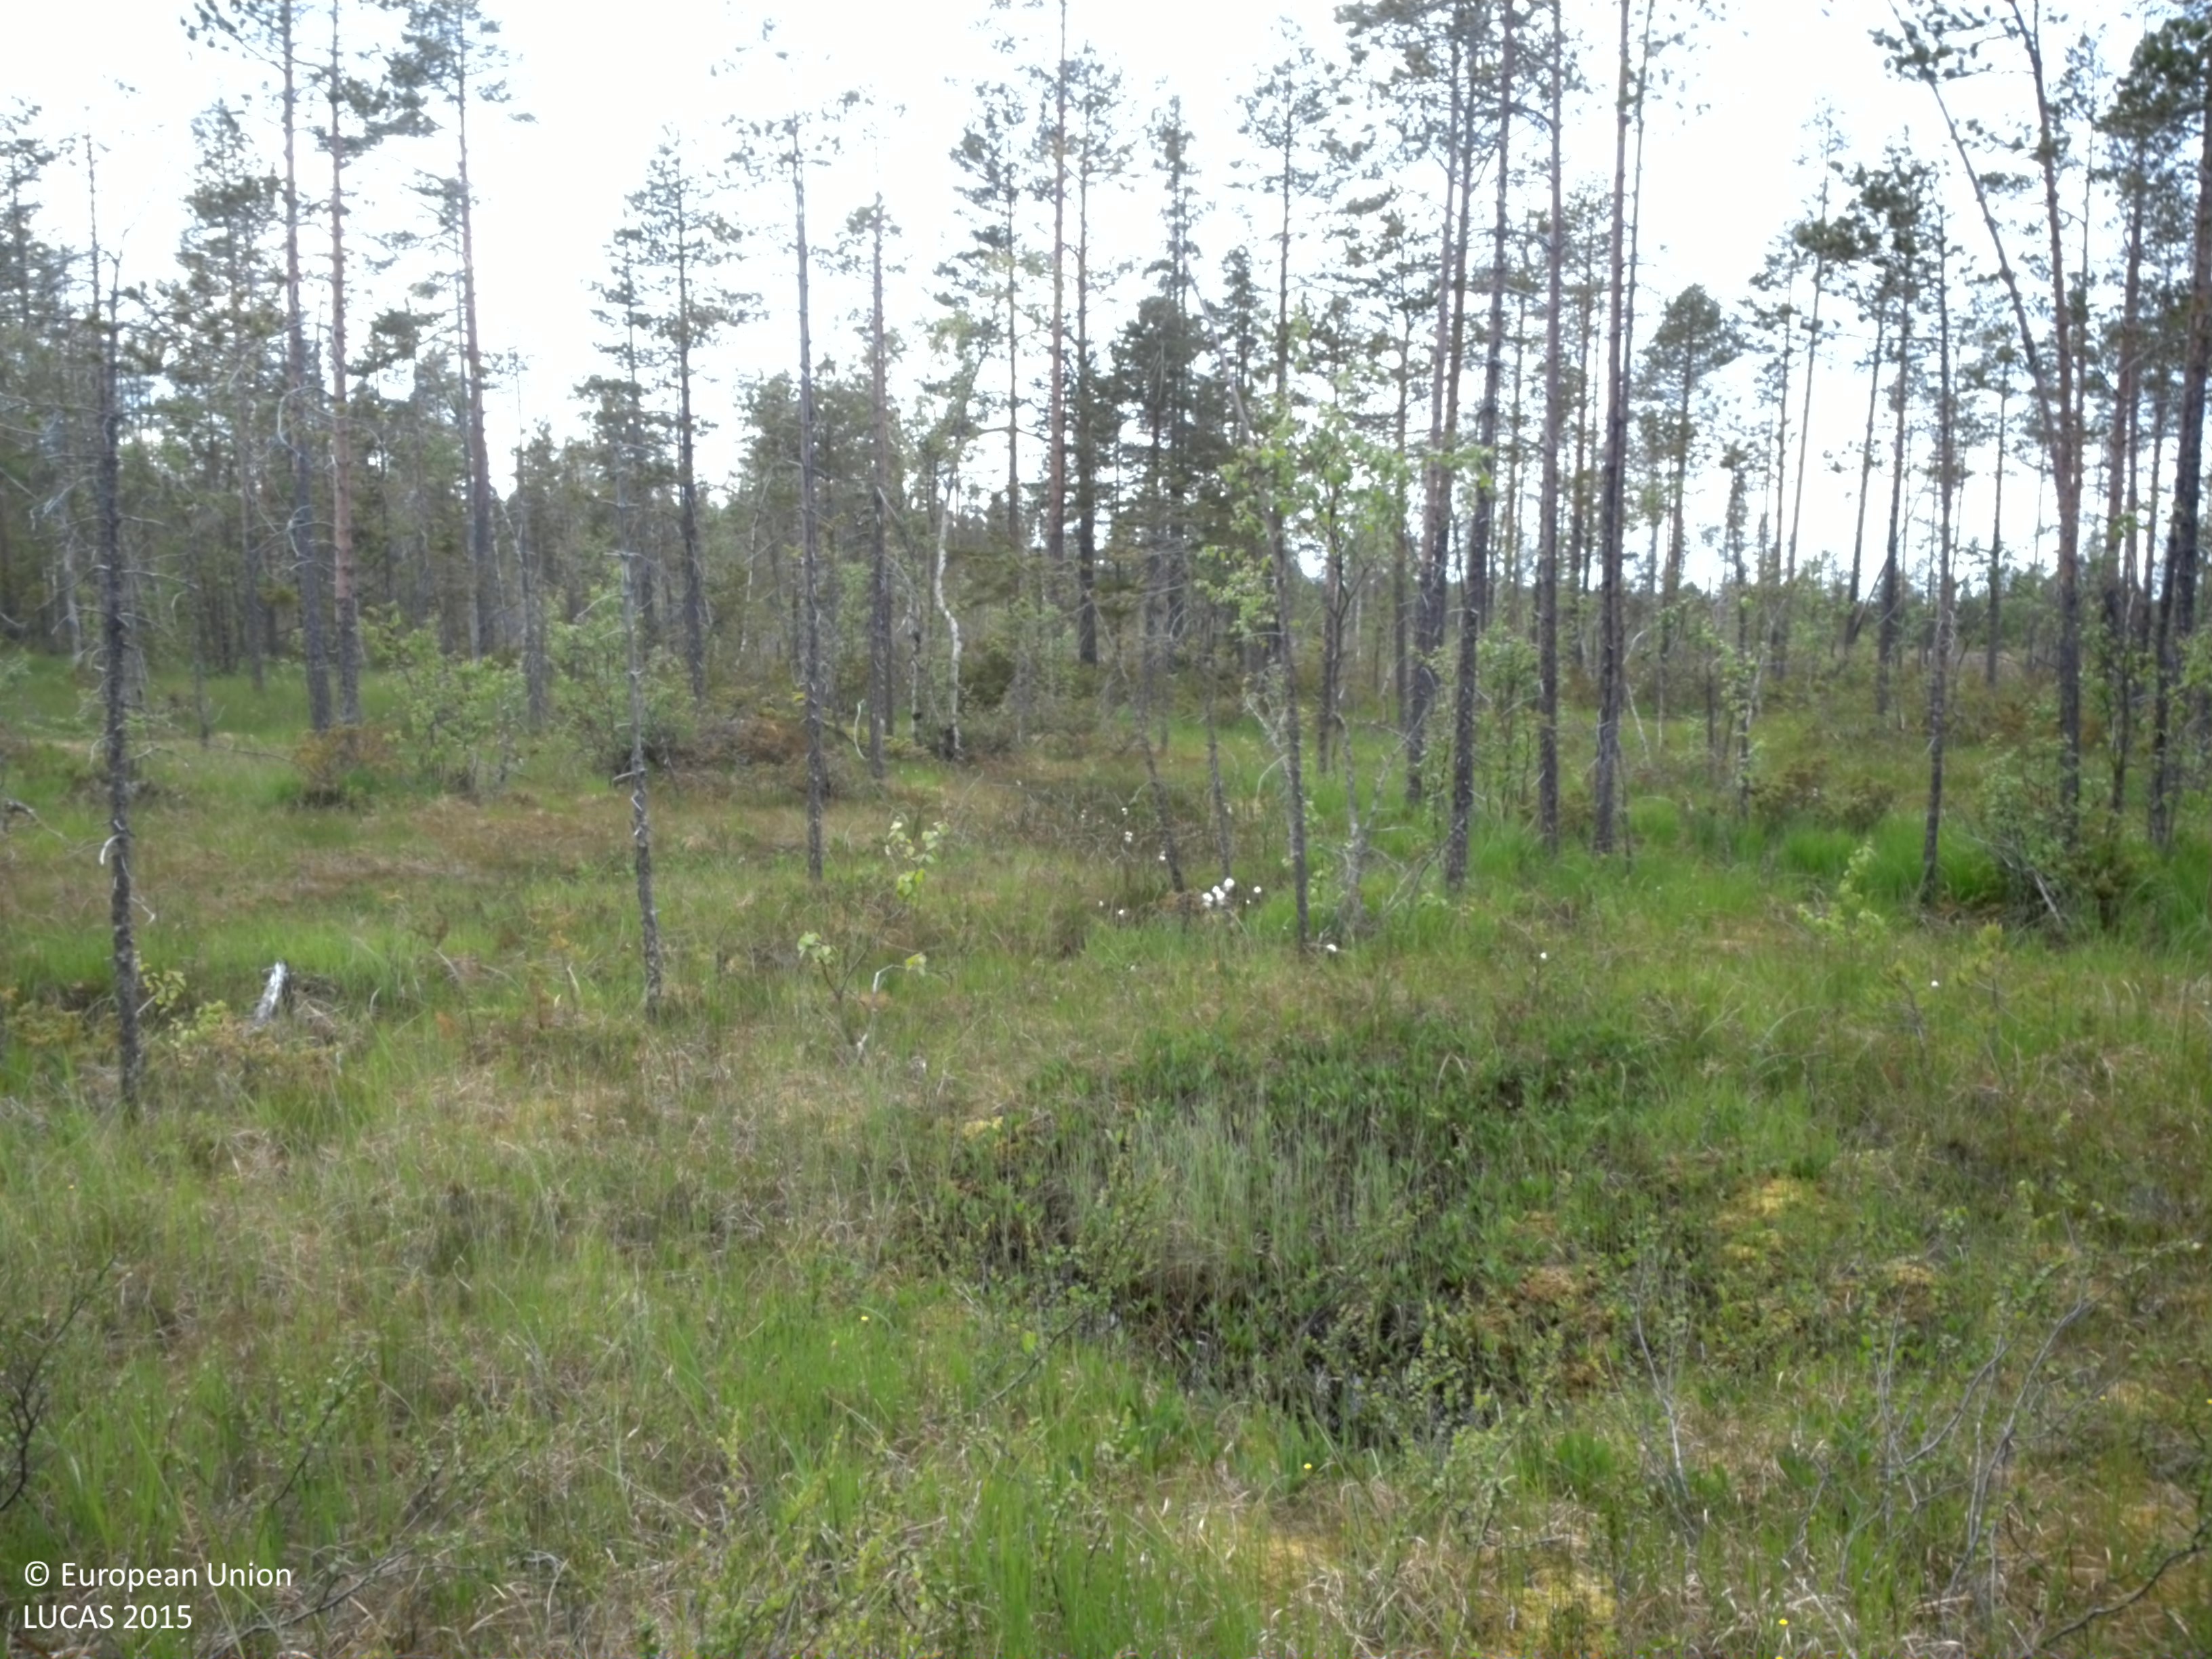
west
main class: Woodland
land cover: Pine dominated coniferous woodland
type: mire and swamp forests
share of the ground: 10 - 25 %
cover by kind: herbaceous plants 45 %, shrubs 25 %, coniferous forest trees 20 %, broadleaved forest trees 5 %, lichens and mosses 5 %
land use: Semi-natural and natural areas not in use
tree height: < 5 m
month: July
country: SE
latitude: 64.4128
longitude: 20.7921
